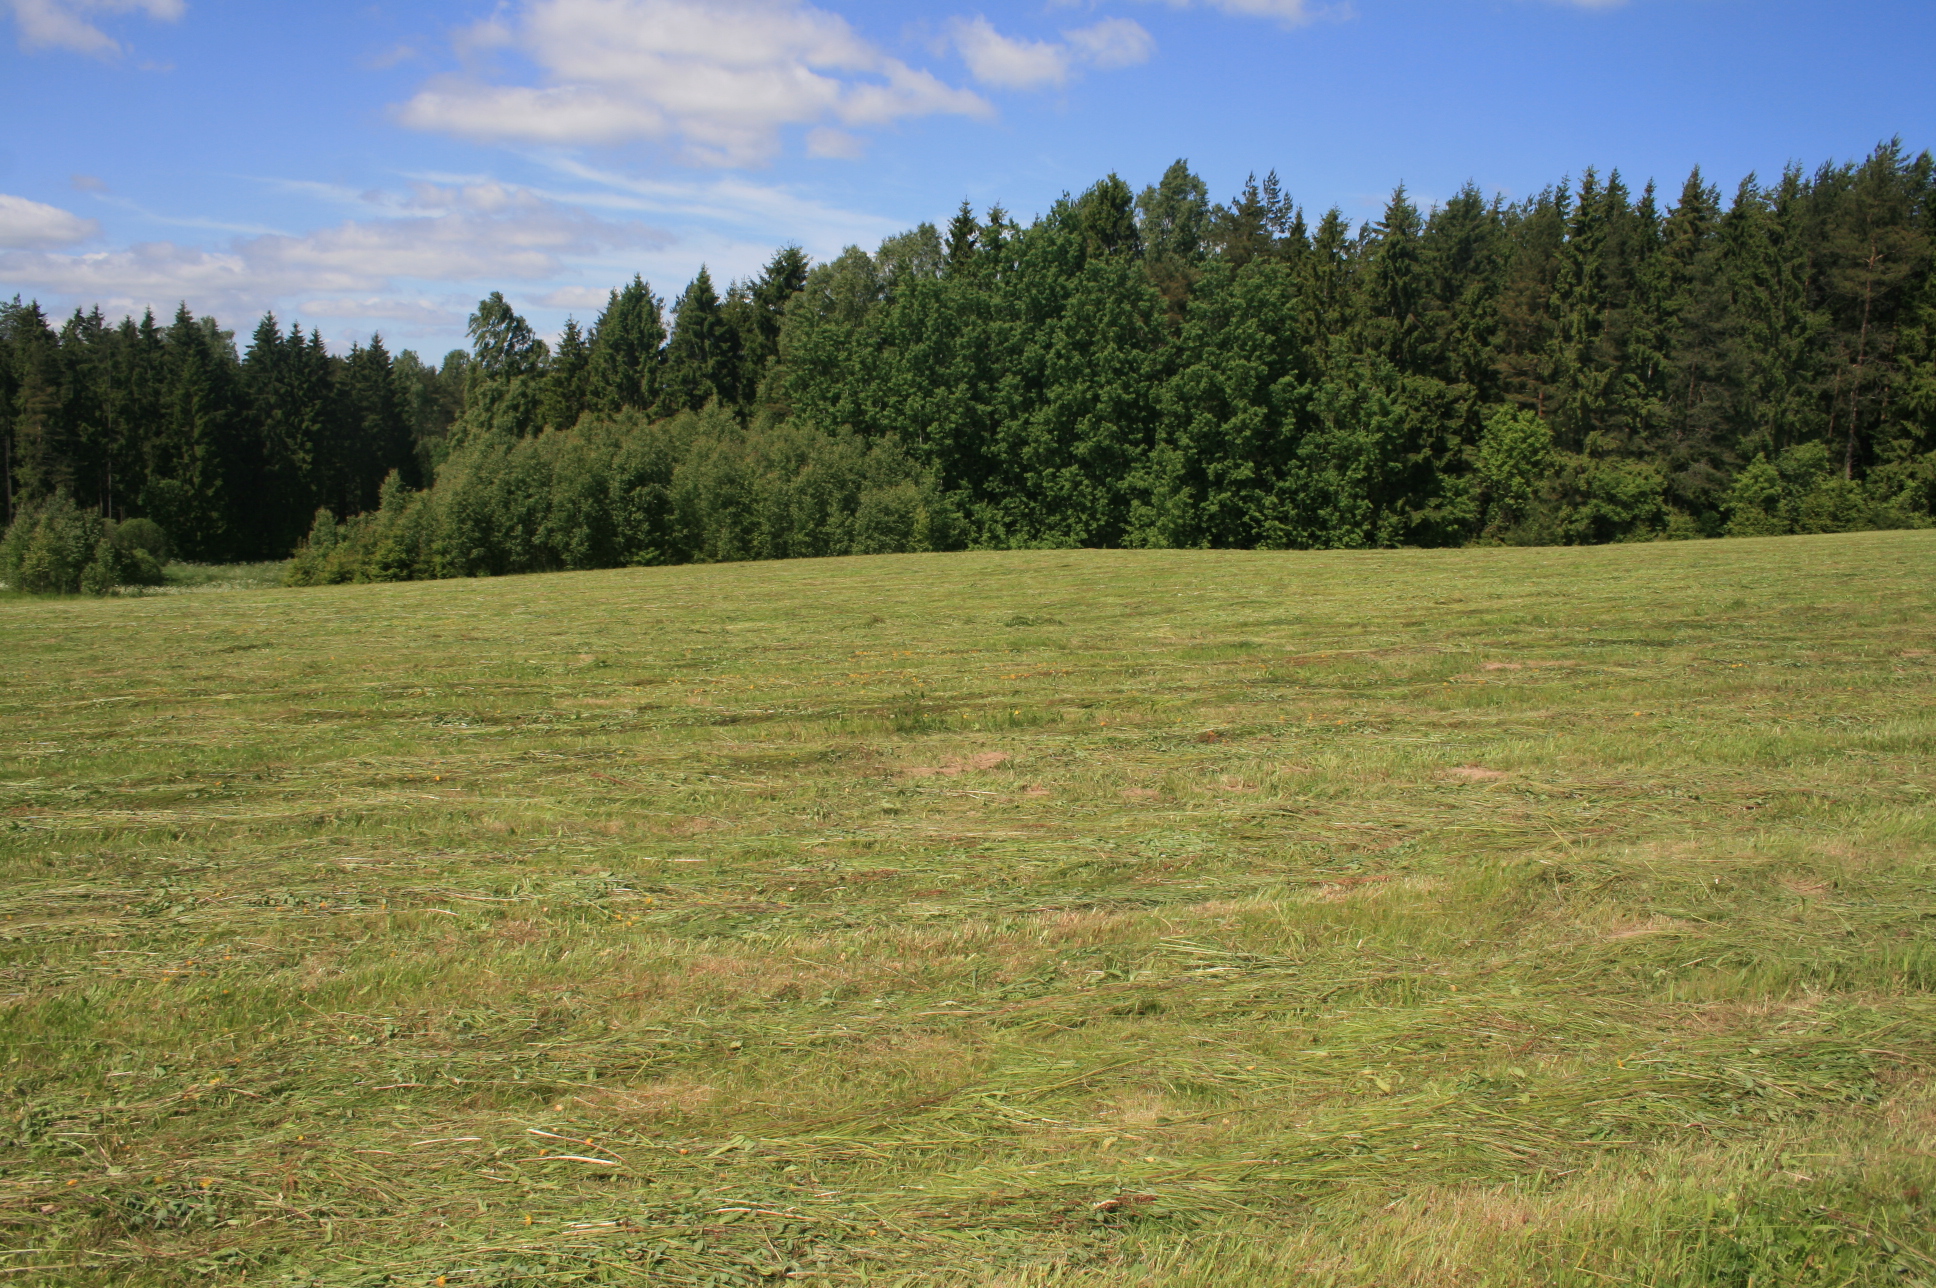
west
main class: Grassland
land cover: Grassland without tree/shrub cover
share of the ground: > 75 %
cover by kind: herbaceous plants 100 %
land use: Agriculture (excluding fallow land and kitchen gardens)
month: June
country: LT
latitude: 55.8506
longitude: 22.2755
